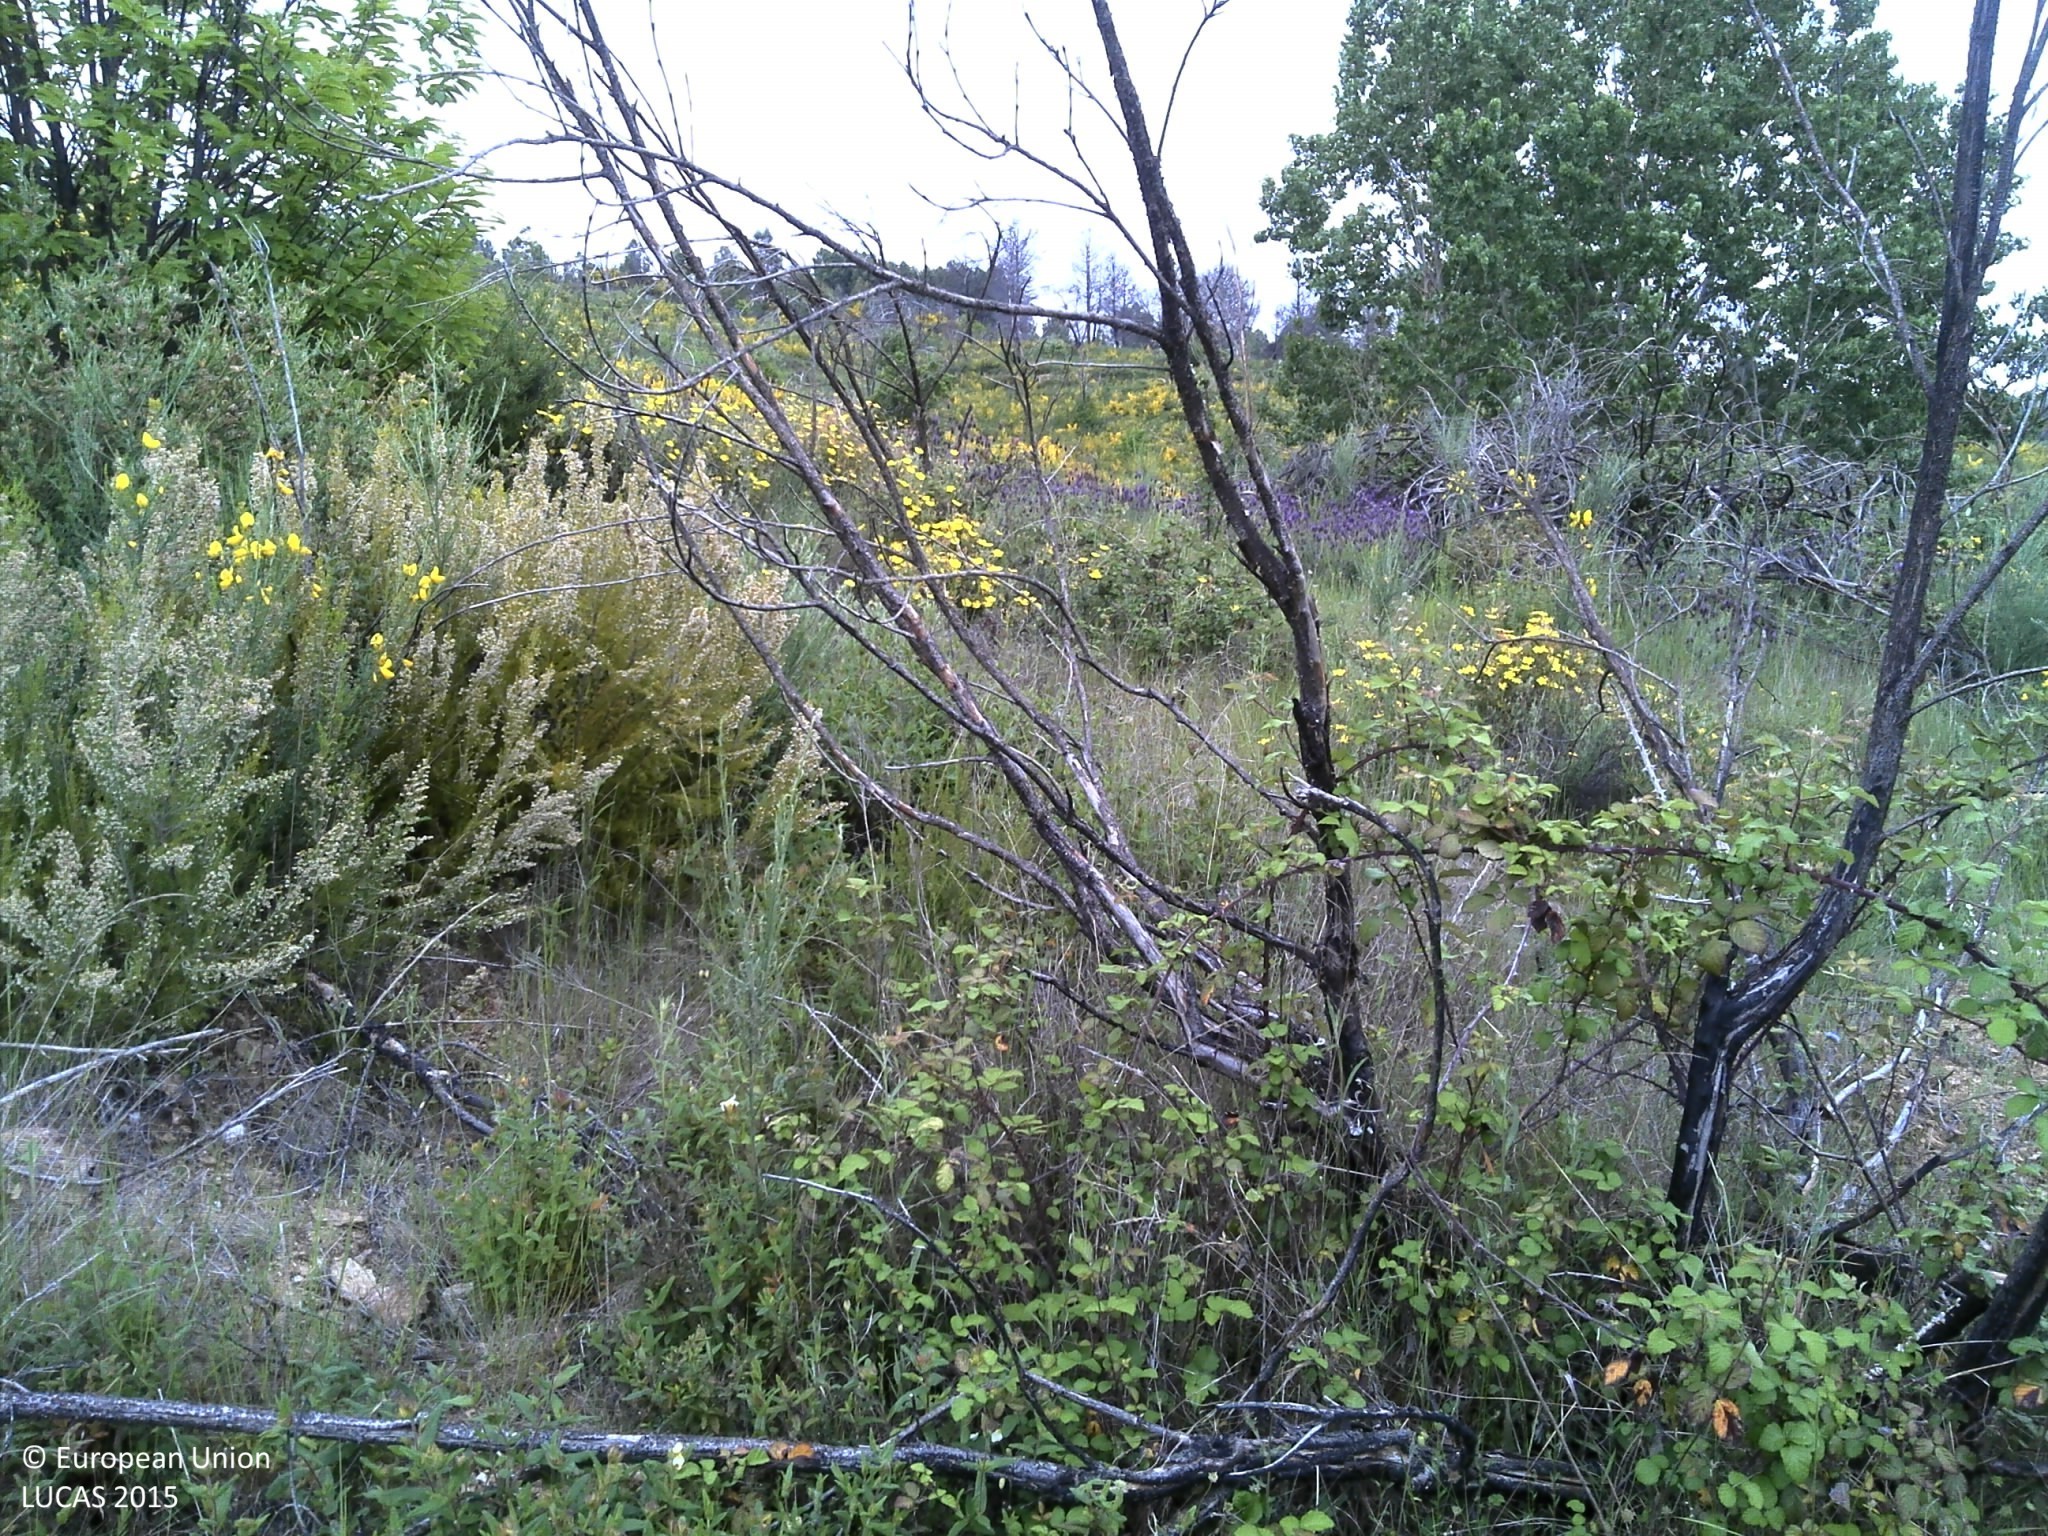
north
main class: Shrubland
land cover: Shrubland with sparse tree cover
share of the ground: 25 - 50 %
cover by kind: shrubs 50 %, unconsolidated bare surface 40 %, broadleaved forest trees 5 %, herbaceous plants 5 %
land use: Forestry
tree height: < 5 m
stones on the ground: 10 - 25 %
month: May
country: PT
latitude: 41.7947
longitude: -7.1017
